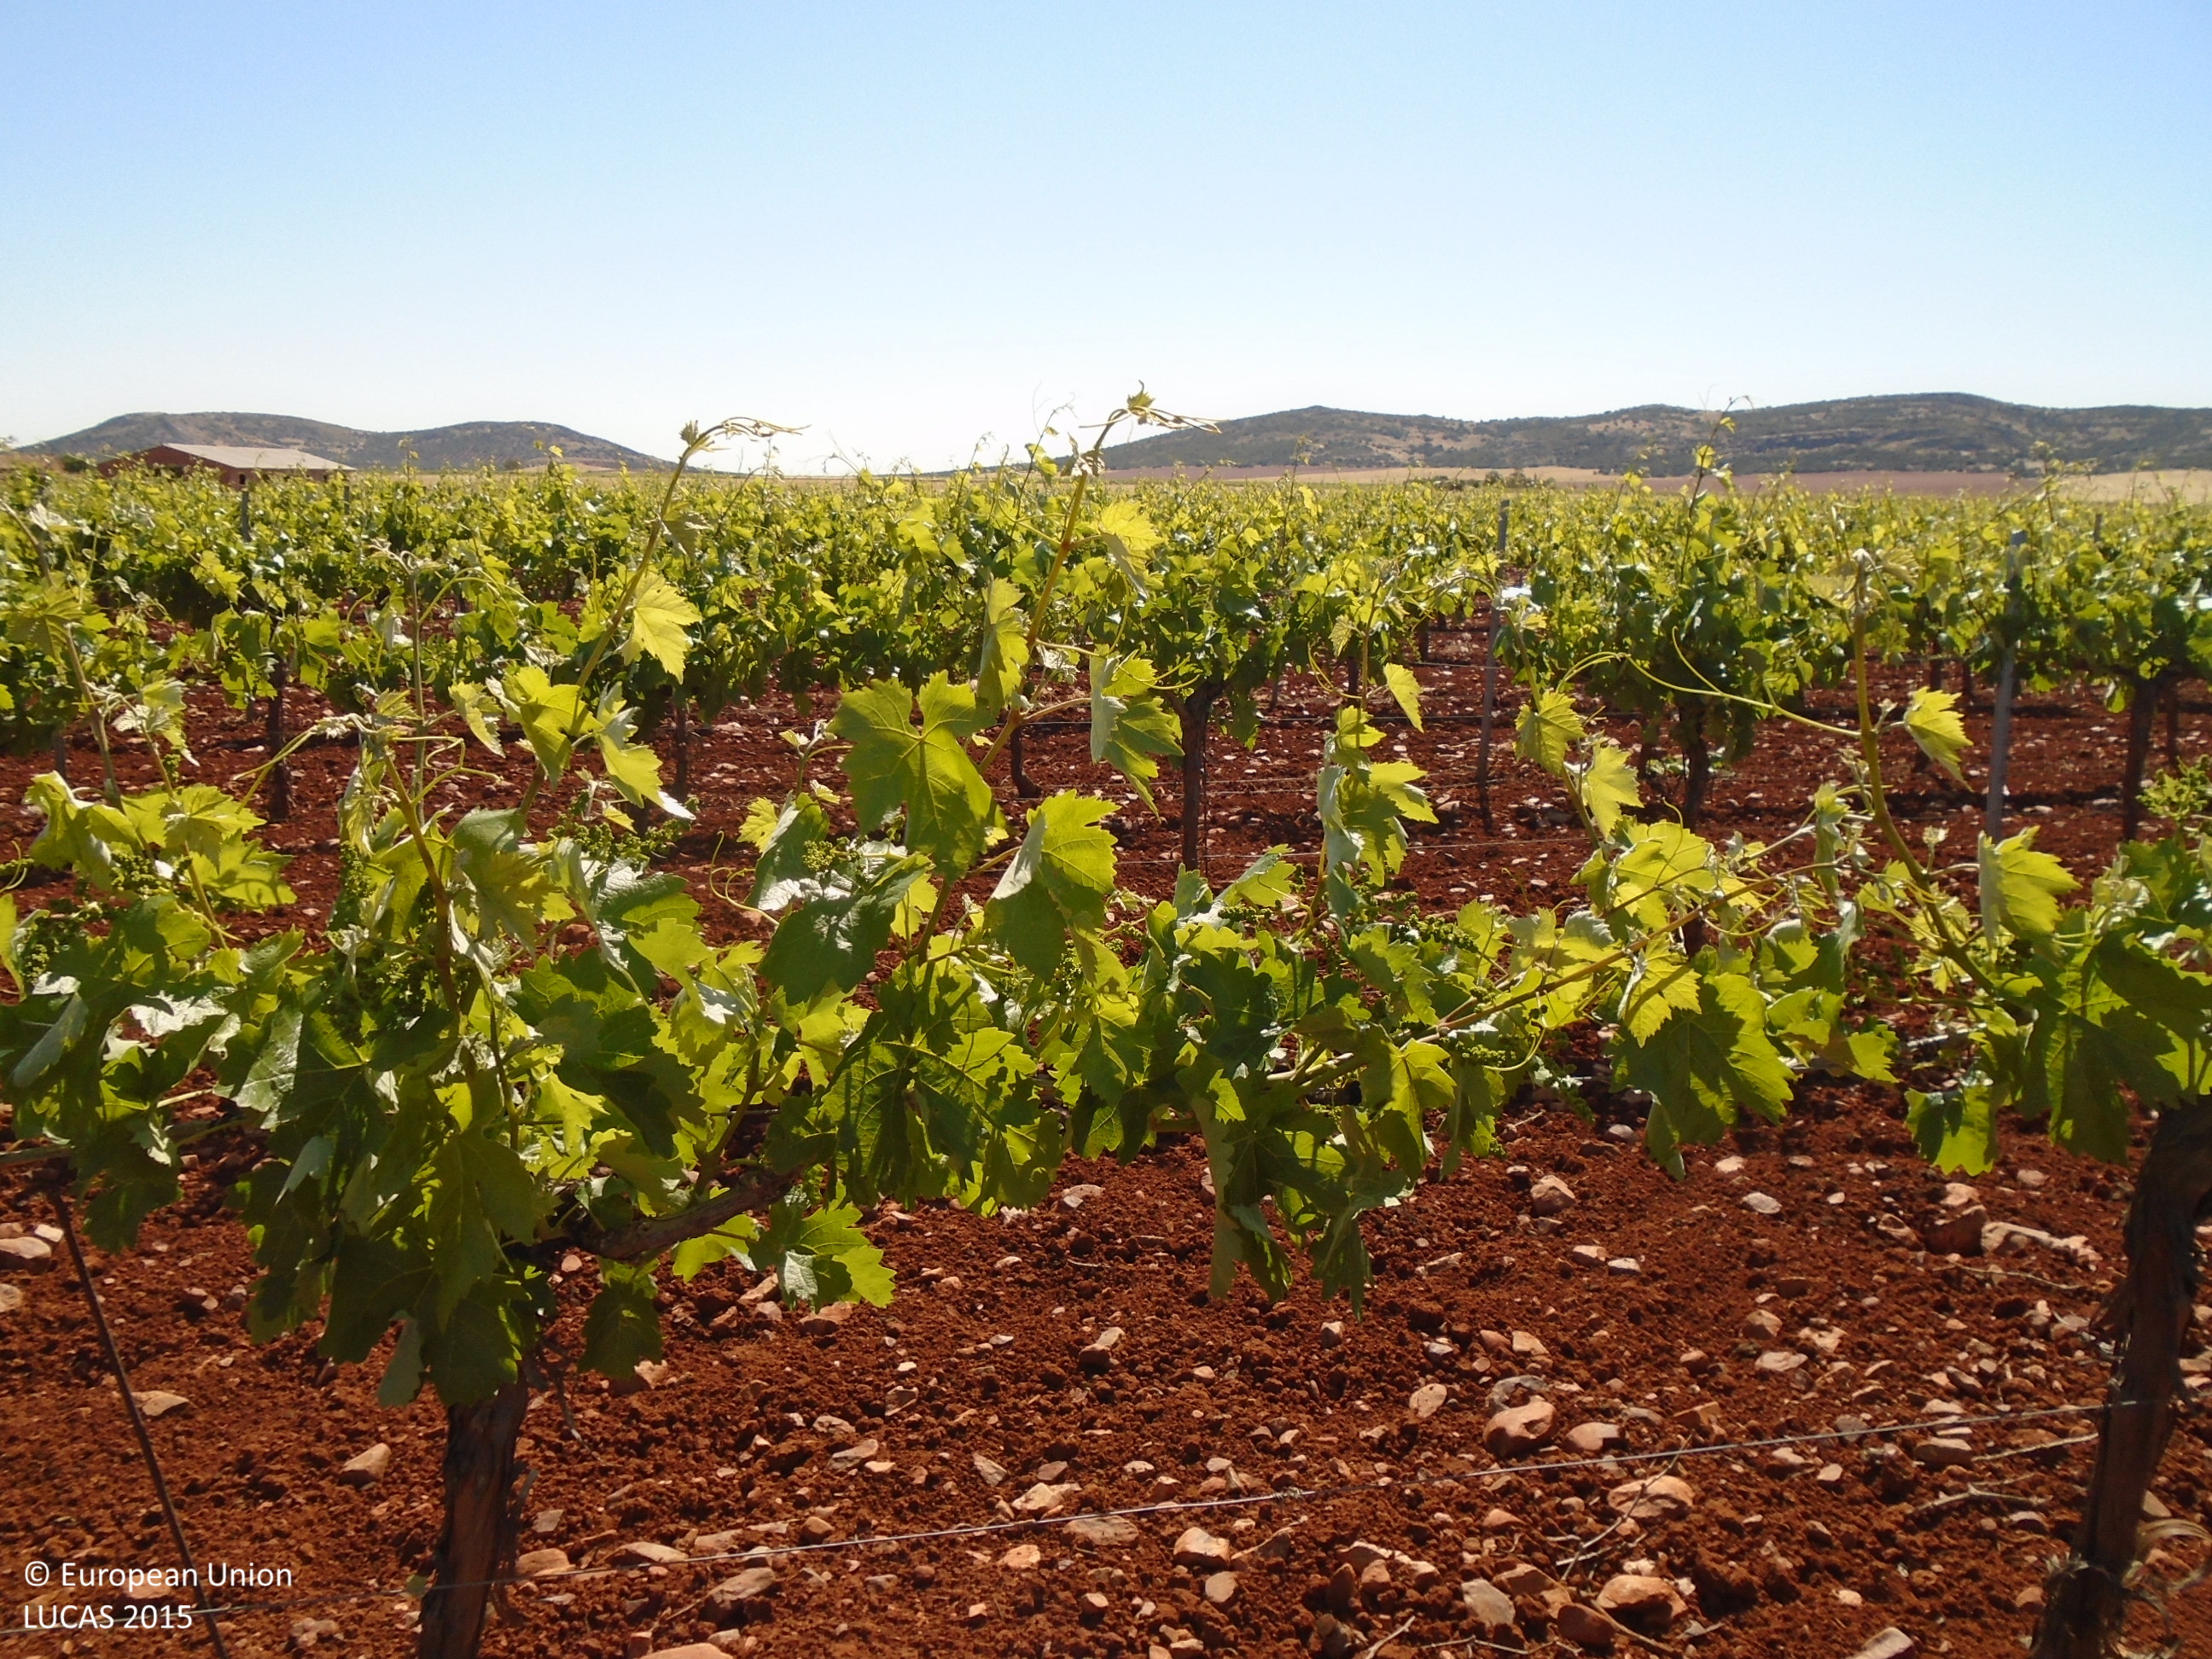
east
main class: Cropland
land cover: Vineyards
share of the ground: 25 - 50 %
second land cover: Other bare soil
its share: > 75 %
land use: Agriculture (excluding fallow land and kitchen gardens)
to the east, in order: Vineyards; Other bare soil; Tracks; Vineyards; Tracks; Barley; Grass margins; Vineyards; Grass margins; Tracks; Grass margins; Barley
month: May
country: ES
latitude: 39.4832
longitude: -3.7090
